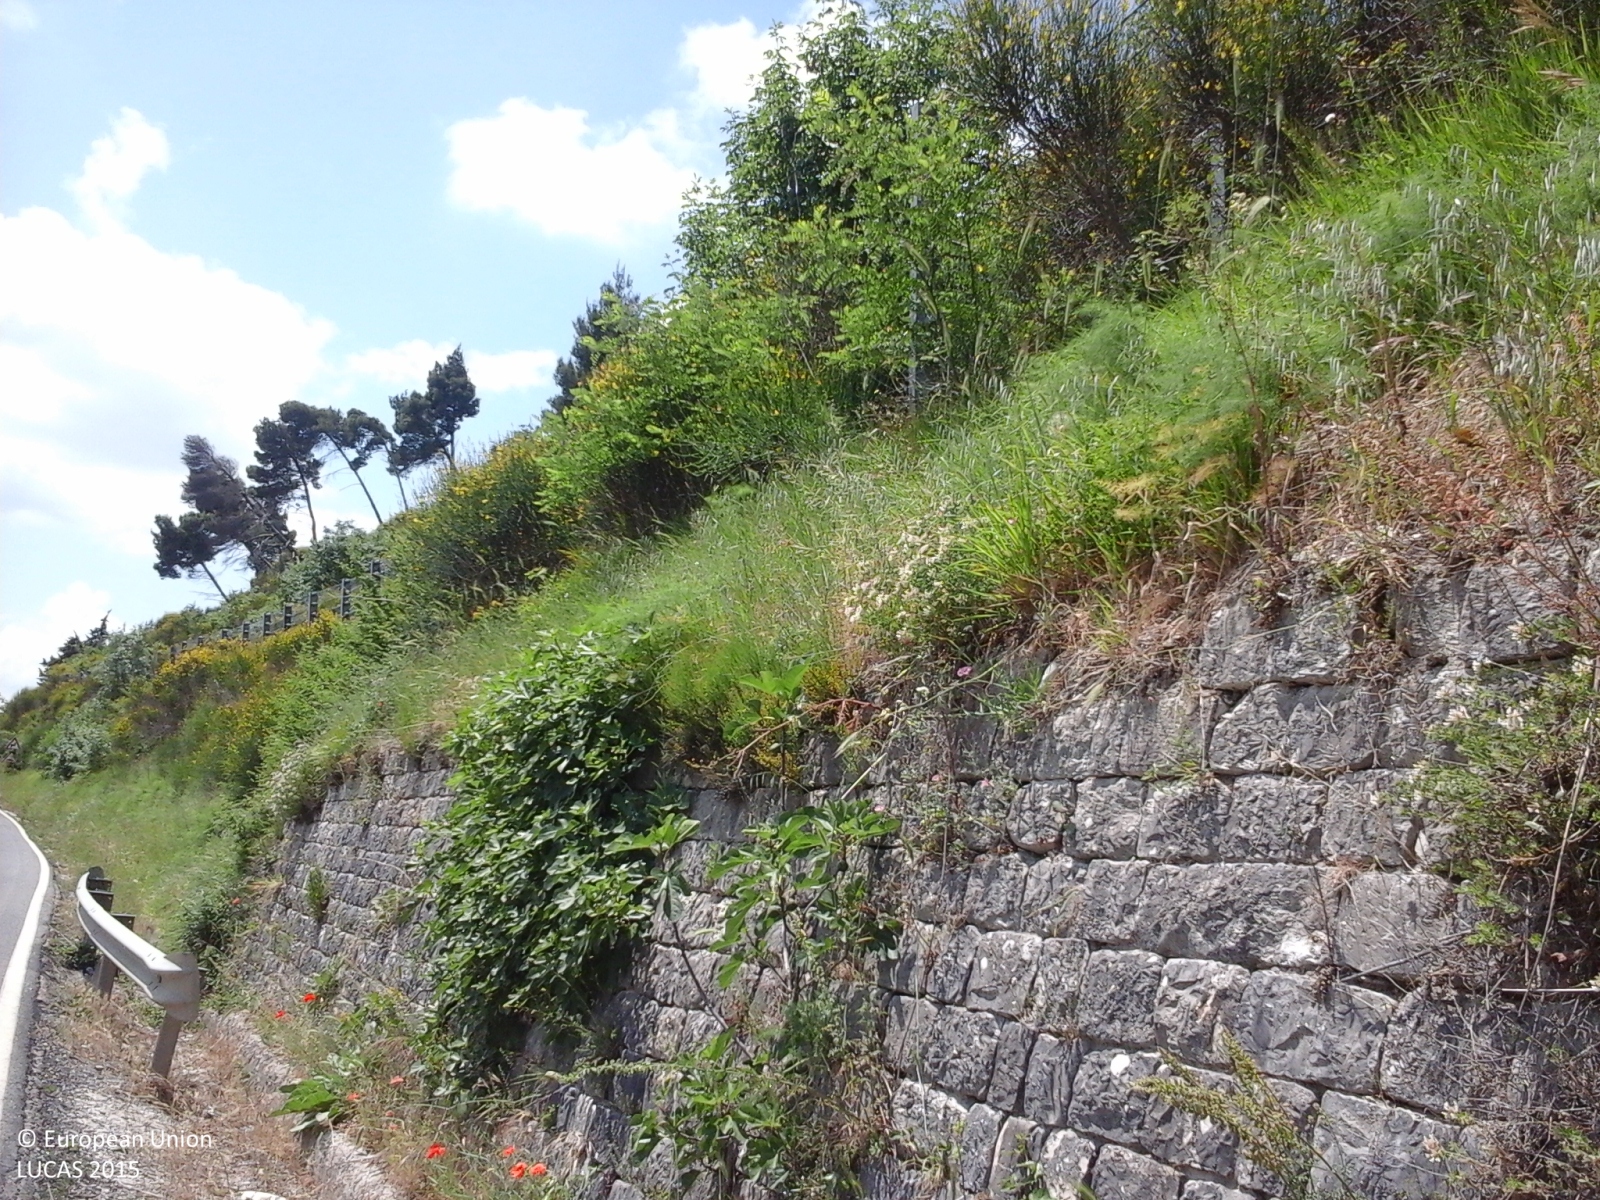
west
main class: Shrubland
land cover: Shrubland with sparse tree cover
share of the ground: > 75 %
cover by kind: shrubs 75 %, herbaceous plants 20 %, coniferous forest trees 5 %
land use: Semi-natural and natural areas not in use
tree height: > 5 m
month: May
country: IT
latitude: 41.2365
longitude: 15.1716
